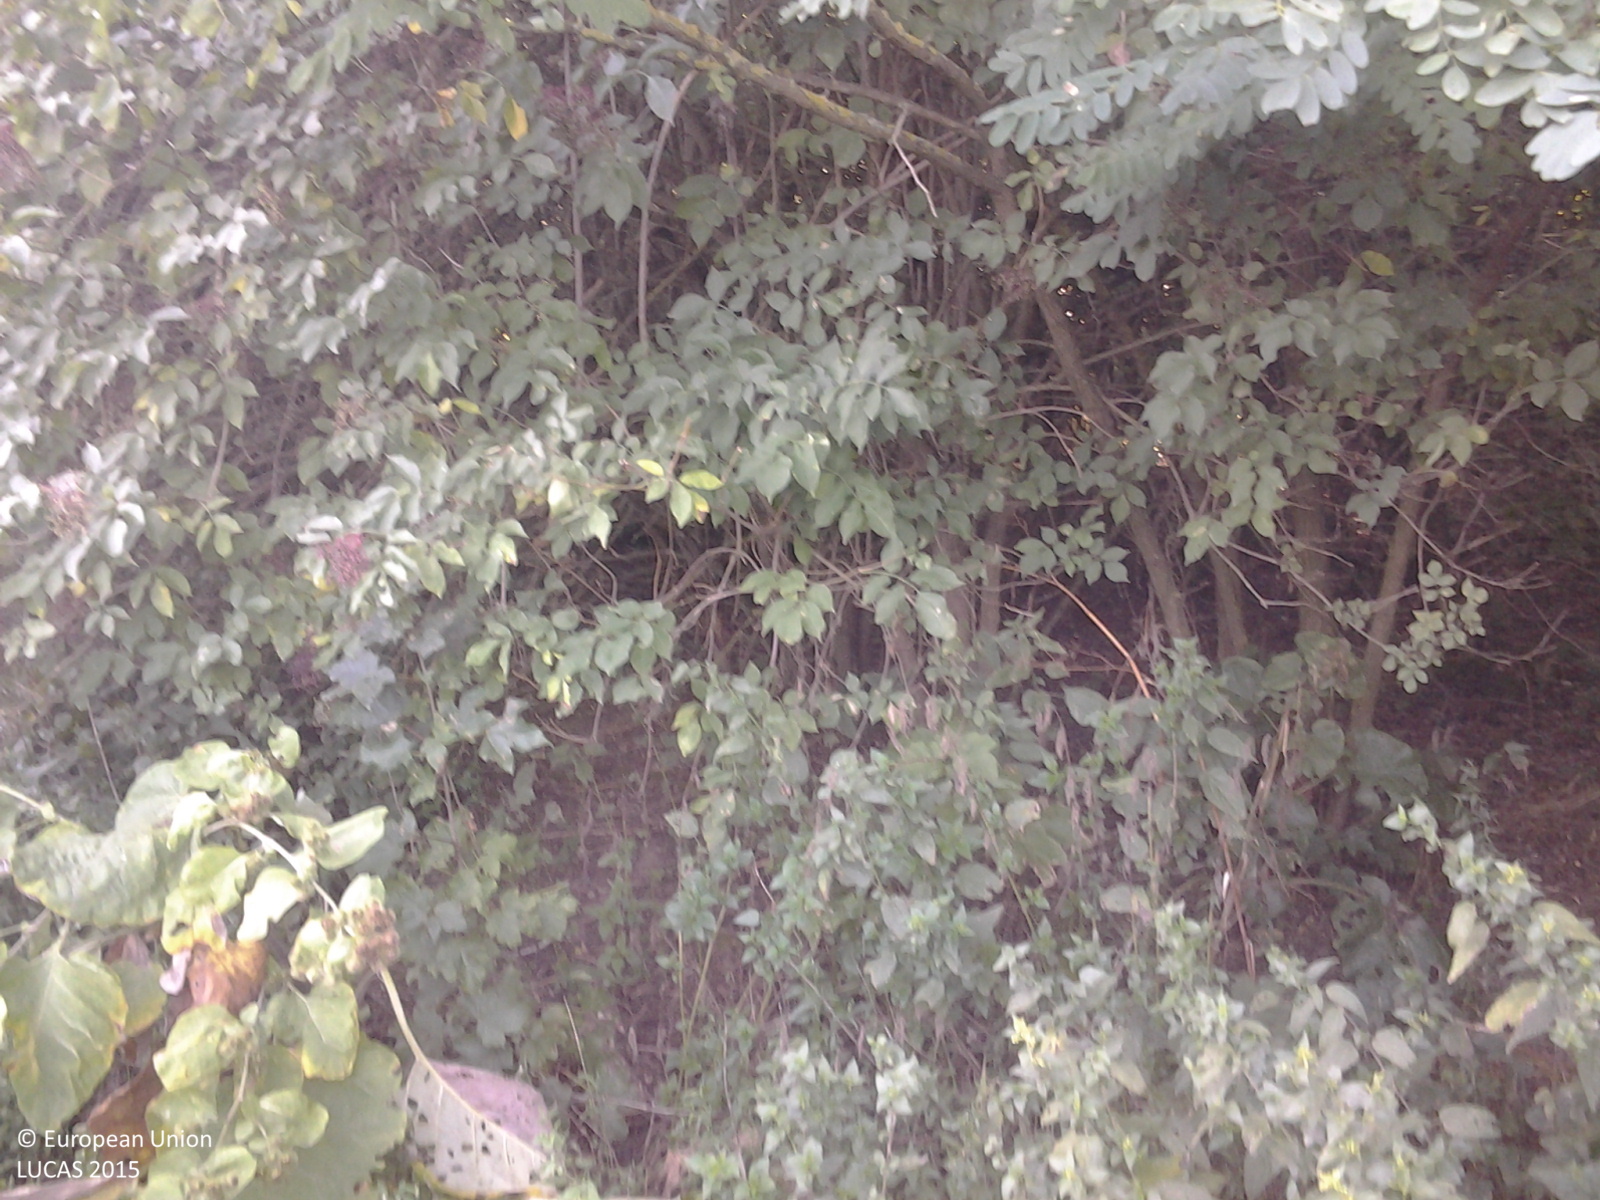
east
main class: Cropland
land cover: Maize
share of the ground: > 75 %
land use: Agriculture (excluding fallow land and kitchen gardens)
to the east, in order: Maize; Grass margins; Tracks; Grass margins; Broadleaved woodland; Tracks; Broadleaved woodland; Abandoned hedges; Ditches and canals; Abandoned hedges; Maize
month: August
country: HU
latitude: 46.8954
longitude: 21.4719
